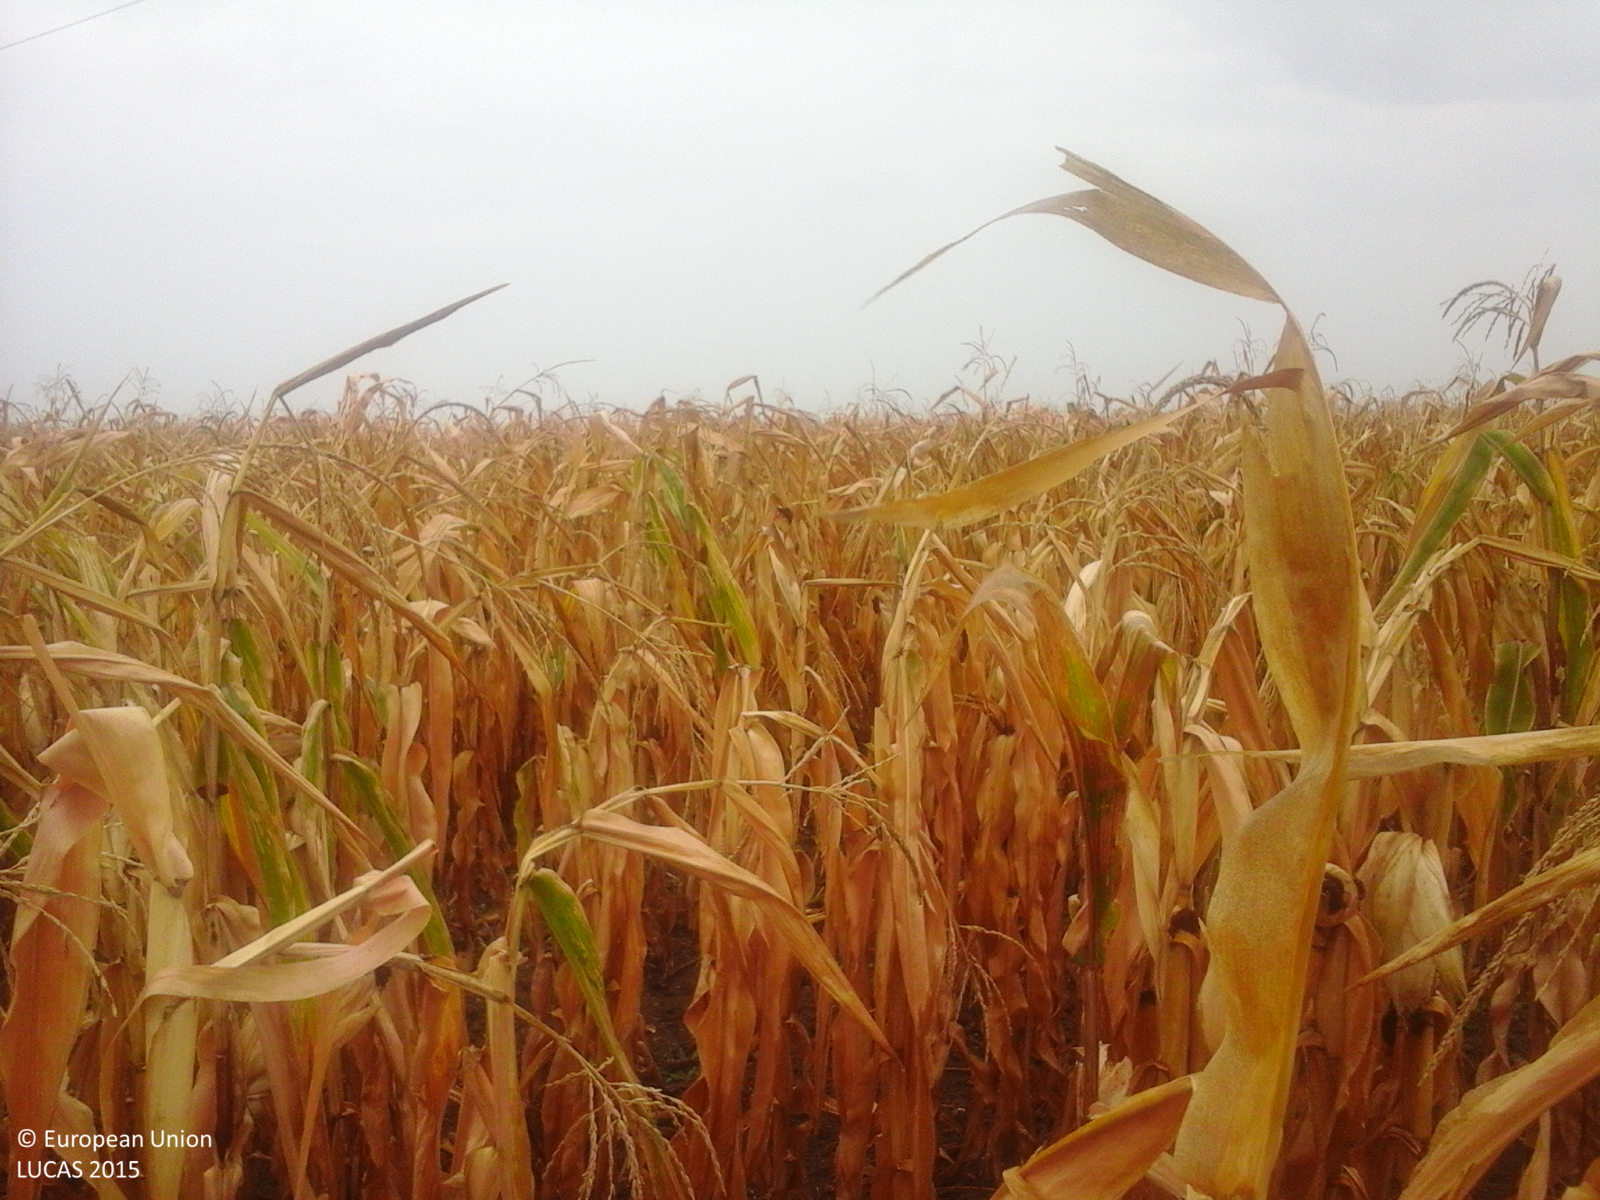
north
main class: Cropland
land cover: Maize
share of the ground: > 75 %
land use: Agriculture (excluding fallow land and kitchen gardens)
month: September
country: RO
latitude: 47.7452
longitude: 22.5020
